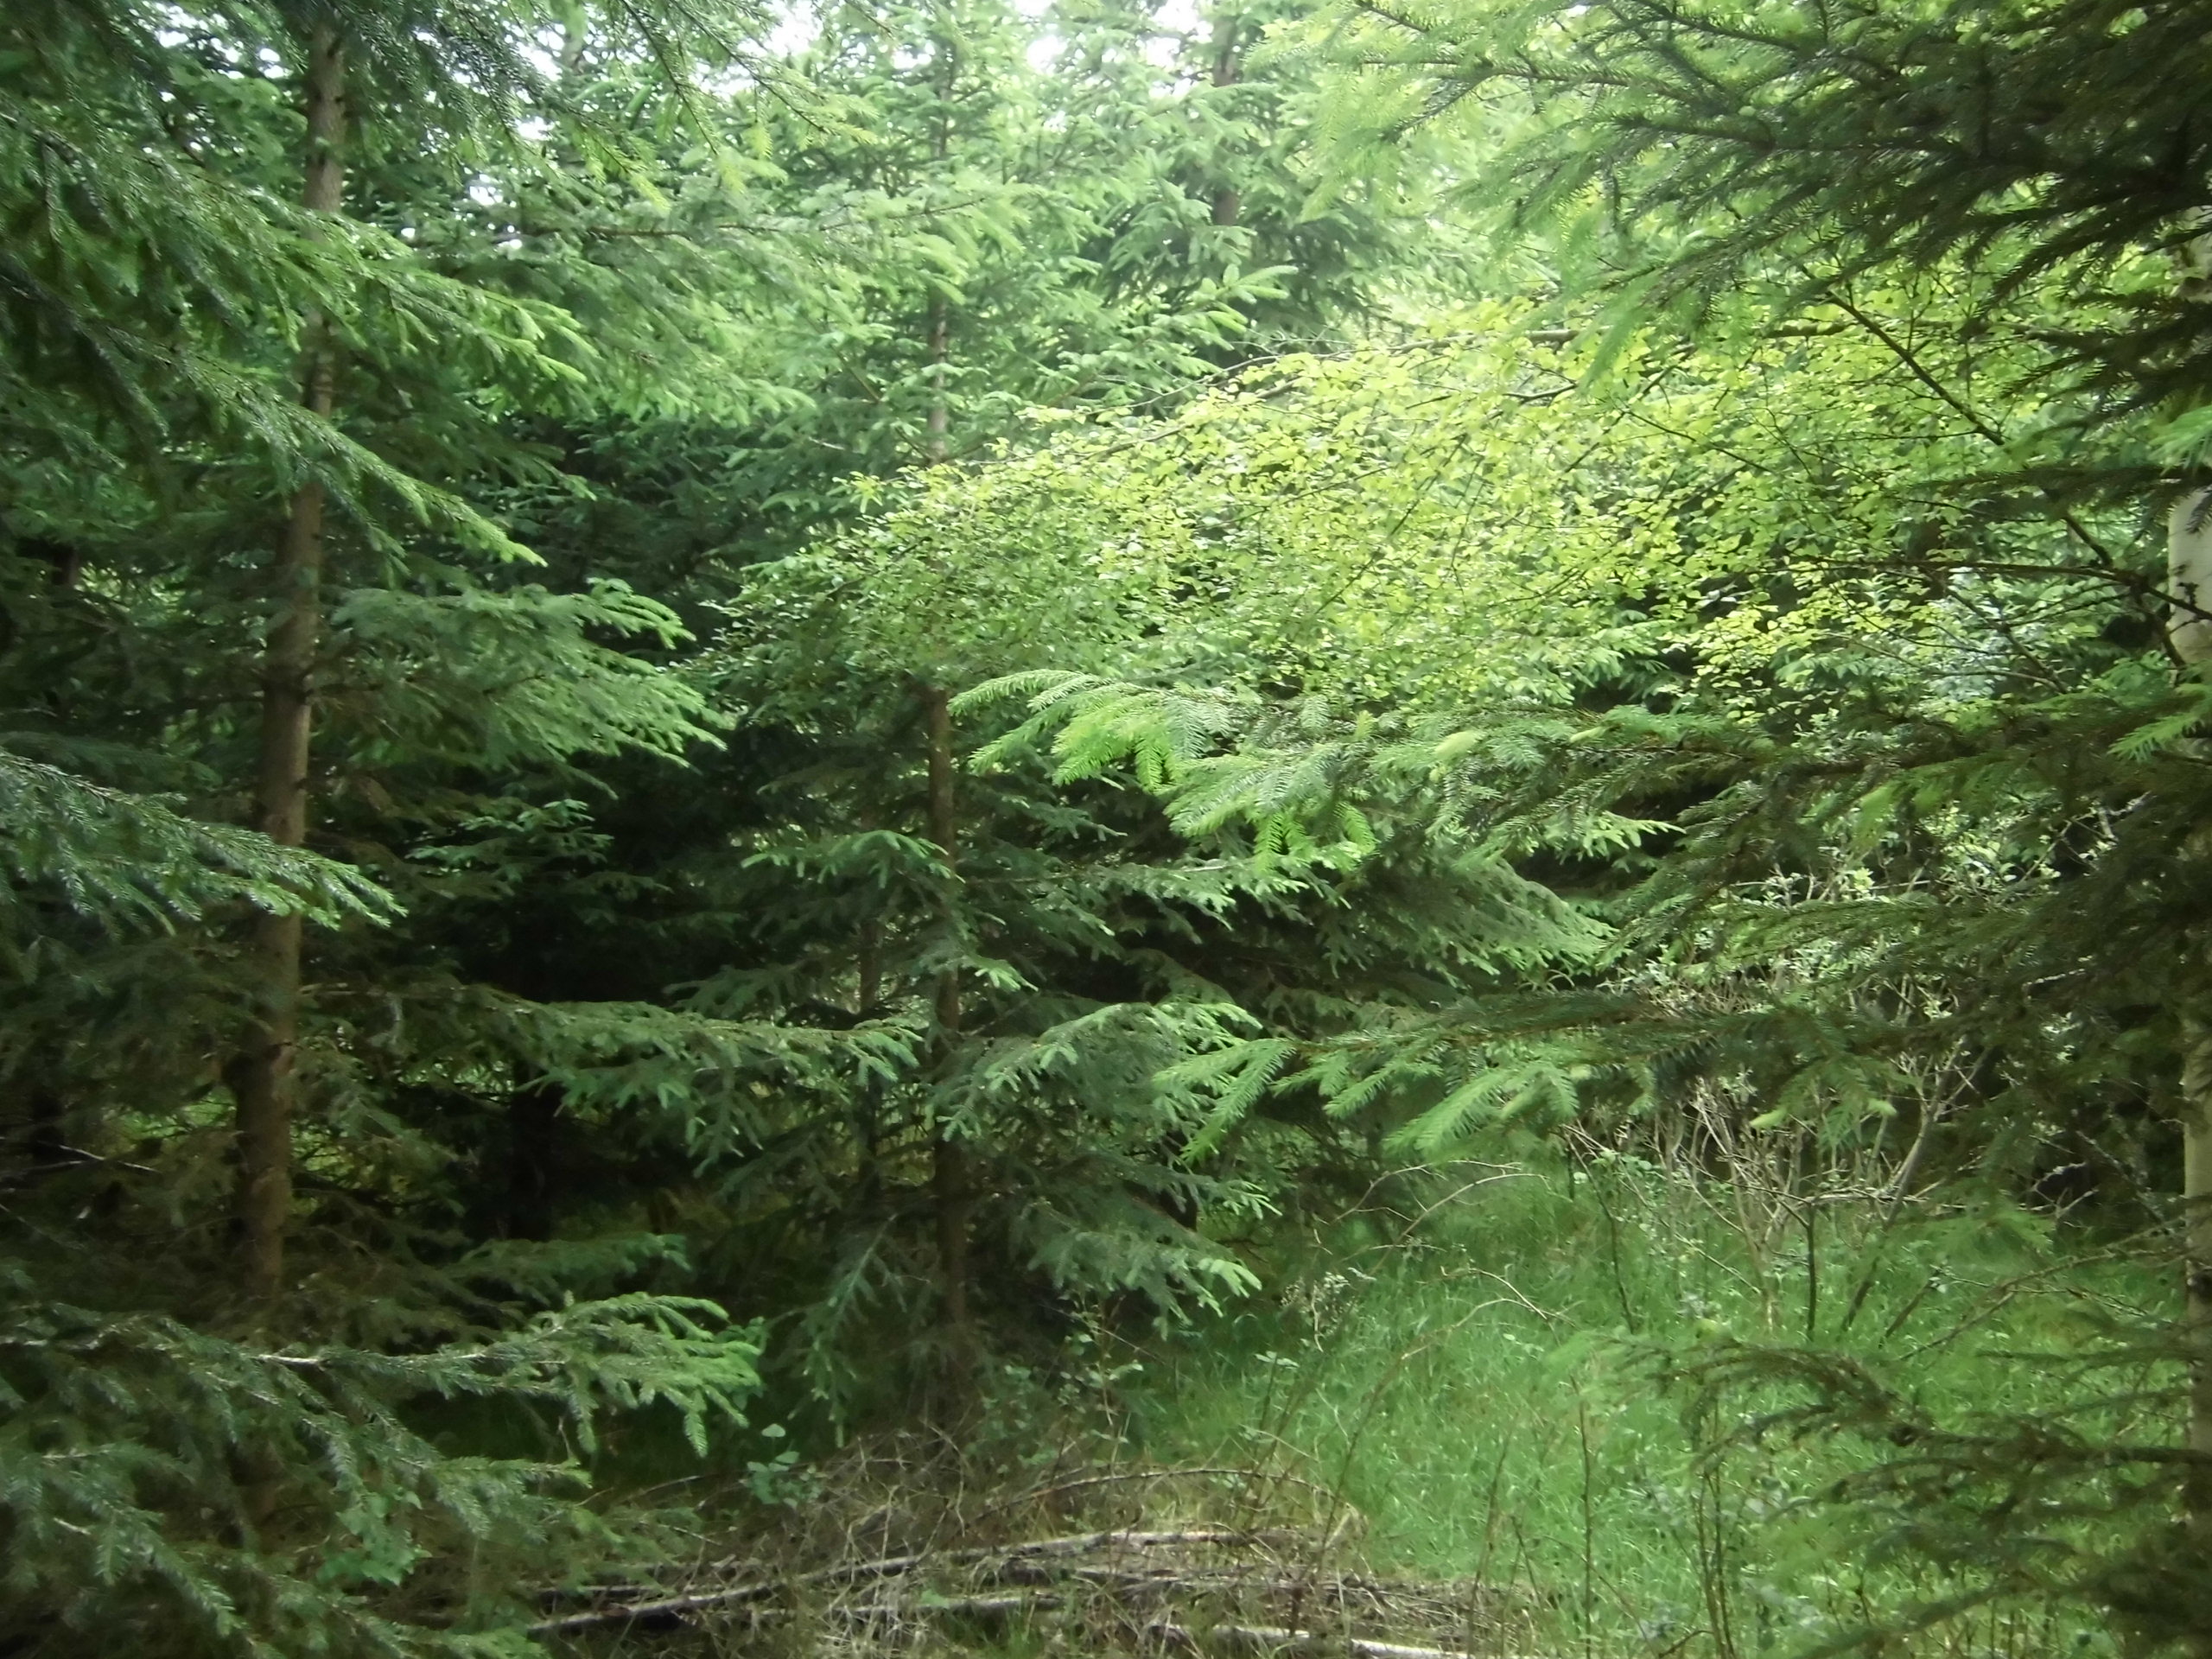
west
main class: Woodland
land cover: Spruce dominated coniferous woodland
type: boreal forest
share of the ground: 50 - 75 %
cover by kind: coniferous forest trees 60 %, herbaceous plants 15 %, broadleaved forest trees 10 %, lichens and mosses 10 %, shrubs 5 %
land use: Forestry
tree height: > 5 m
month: July
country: SE
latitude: 57.4690
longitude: 14.7477
